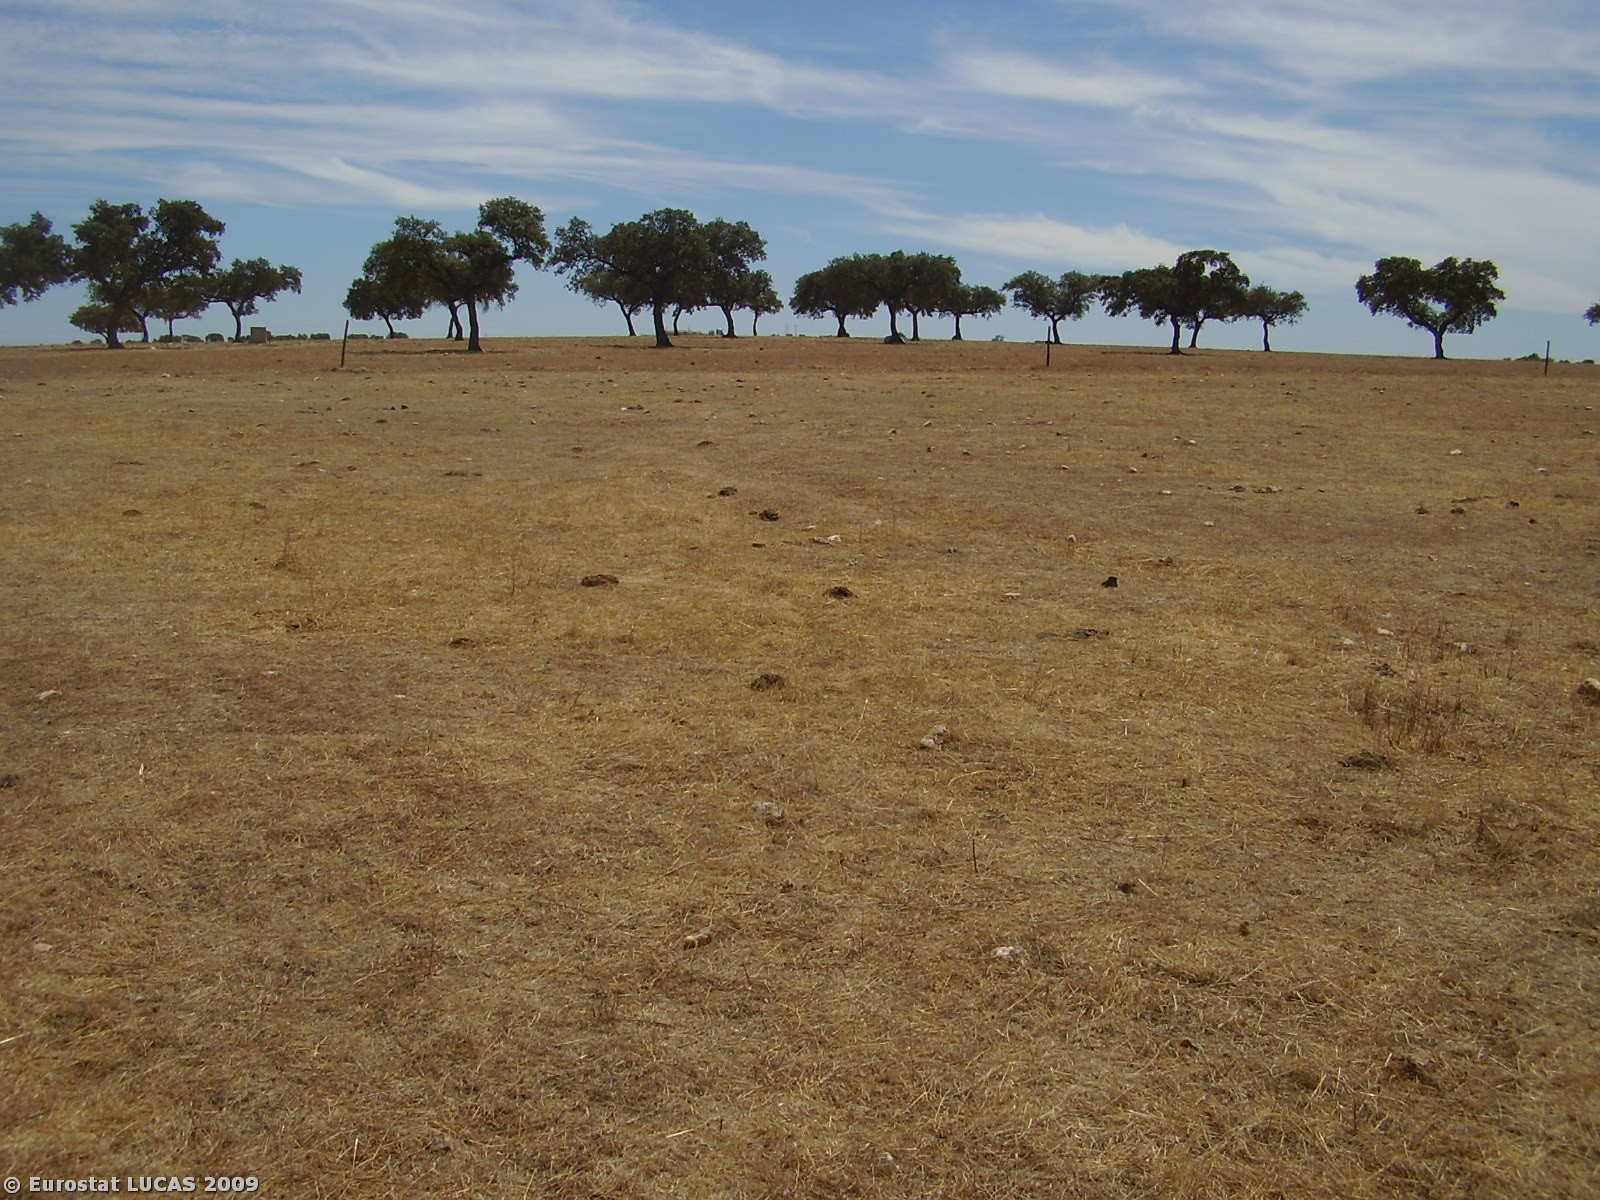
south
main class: Woodland
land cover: Broadleaved woodland
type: broadleaved evergreen forest
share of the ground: 10 - 25 %
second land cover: Grassland with sparse tree/shrub cover
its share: > 75 %
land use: Forestry
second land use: Fallow land
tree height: > 5 m
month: August
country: PT
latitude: 38.2607
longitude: -7.1712
